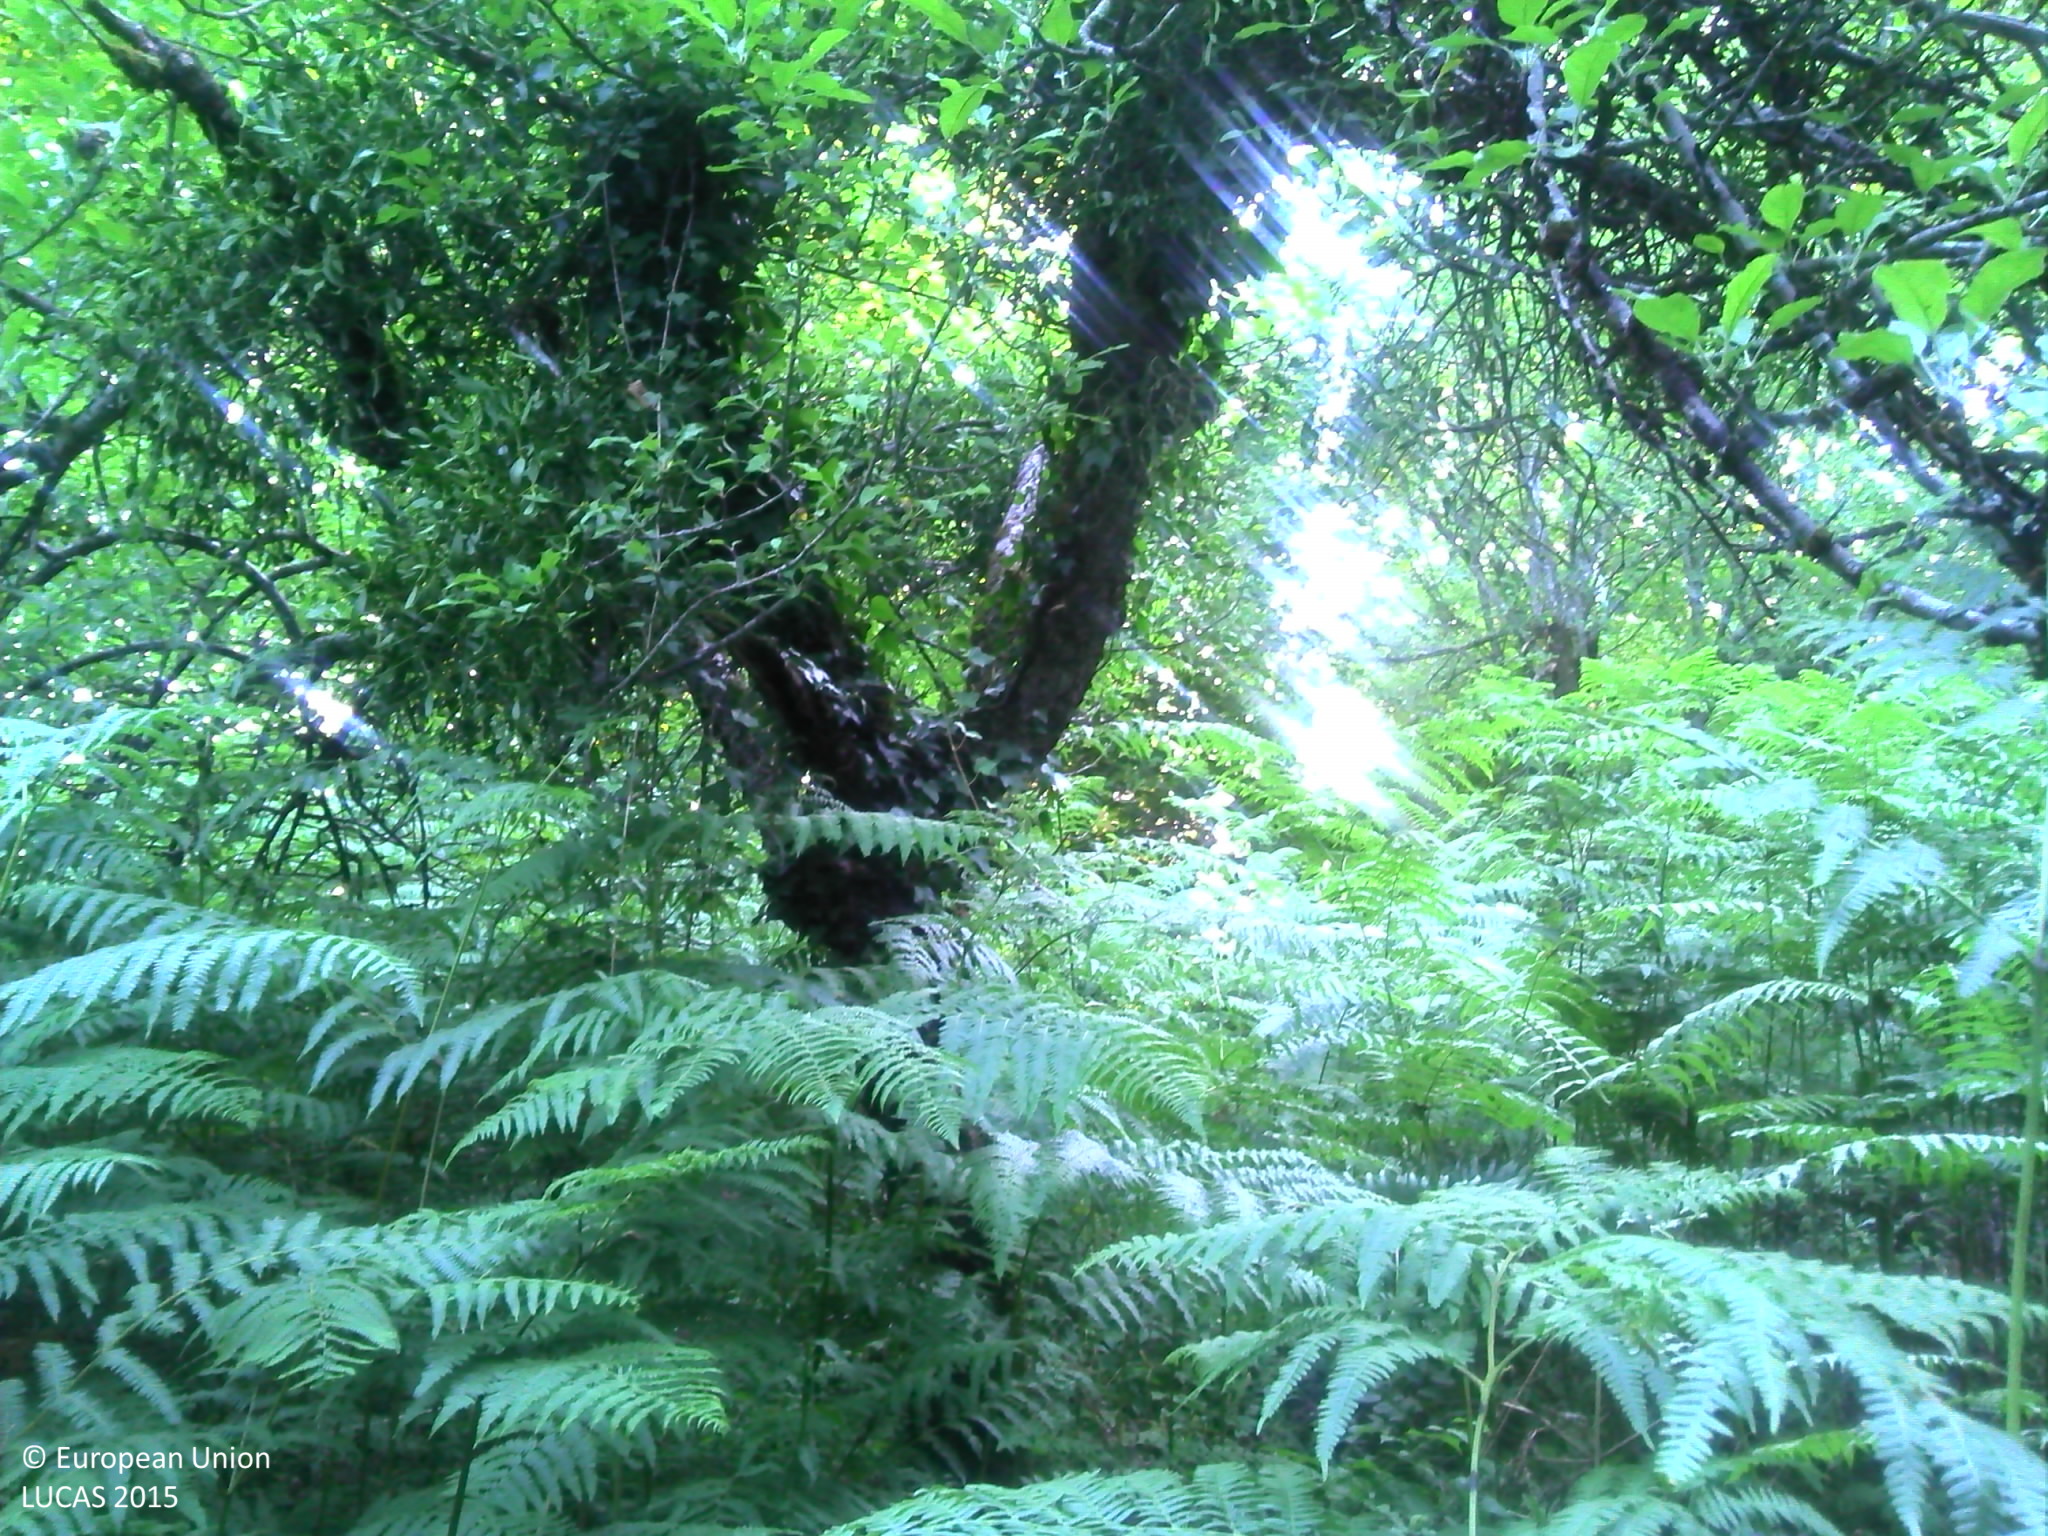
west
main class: Cropland
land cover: Apple fruit
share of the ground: 25 - 50 %
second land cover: Spontaneously vegetated surfaces
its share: 50 - 75 %
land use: Abandoned areas
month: July
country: FR
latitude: 45.9475
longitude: 1.5943
